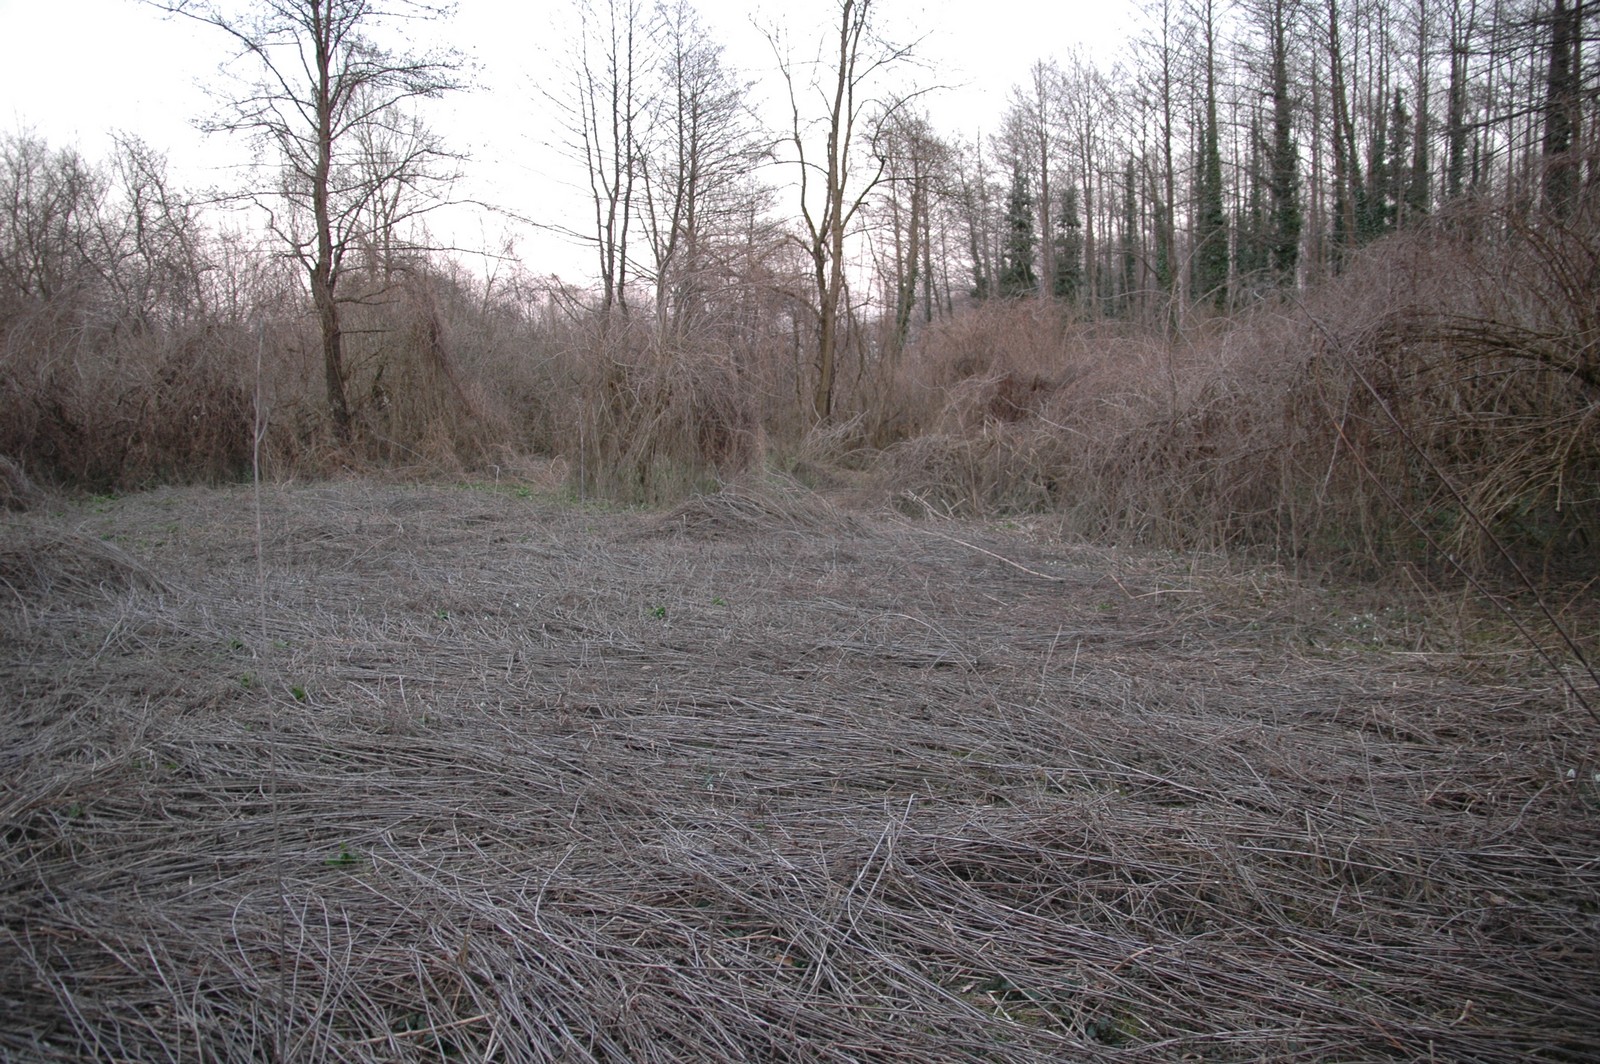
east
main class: Woodland
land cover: Broadleaved woodland
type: mesophytic deciduous forest
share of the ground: > 75 %
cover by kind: broadleaved forest trees 50 %, shrubs 35 %, herbaceous plants 15 %
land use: Forestry
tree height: > 5 m
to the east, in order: Broadleaved woodland; Shrubland with sparse tree cover; Broadleaved woodland
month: March
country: HR
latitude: 46.3924
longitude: 16.1250
